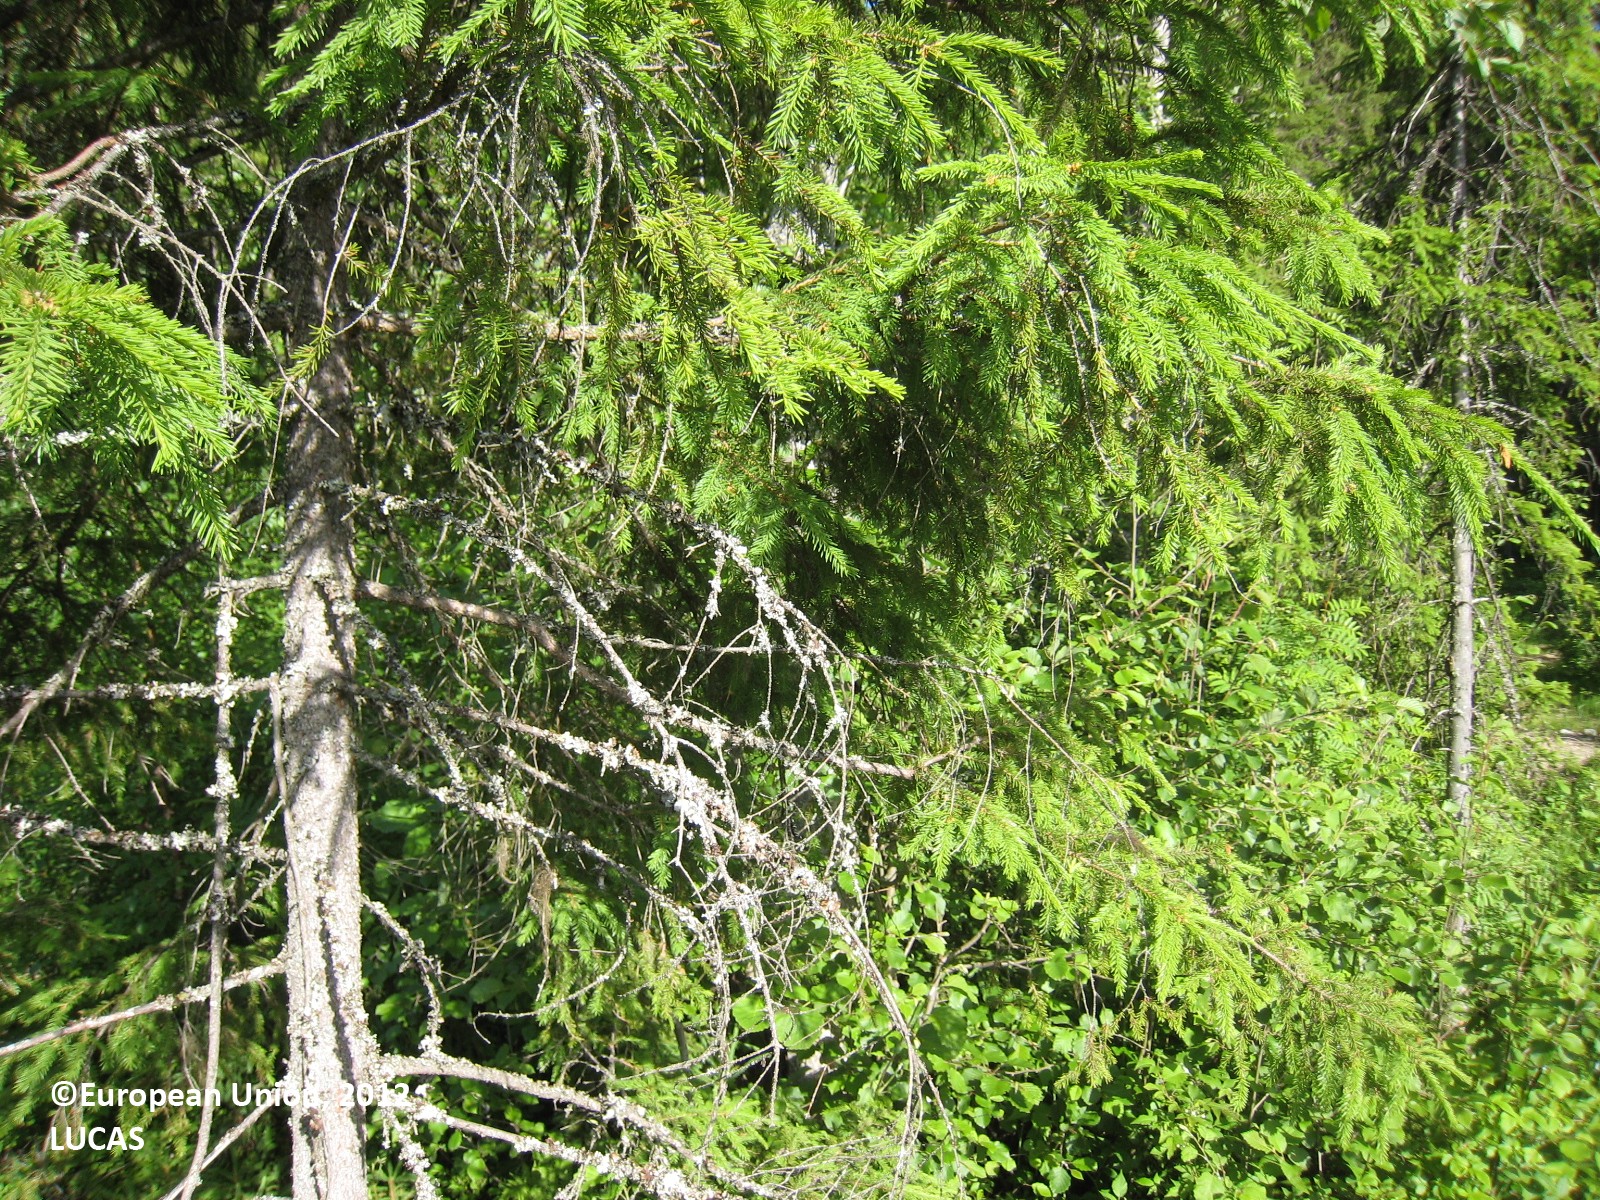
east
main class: Woodland
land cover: Broadleaved woodland
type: boreal forest
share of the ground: 25 - 50 %
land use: Forestry
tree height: < 5 m
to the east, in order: Broadleaved woodland; Ditches and canals; Broadleaved woodland; Tracks; Abandoned hedges; Ditches and canals; Spruce dominated mixed woodland; Other coniferous woodland; Shruby margins; Tracks; Shruby margins; Abandoned hedges; Ditches and canals; Other coniferous woodland
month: June
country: FI
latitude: 62.4840
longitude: 26.5335
